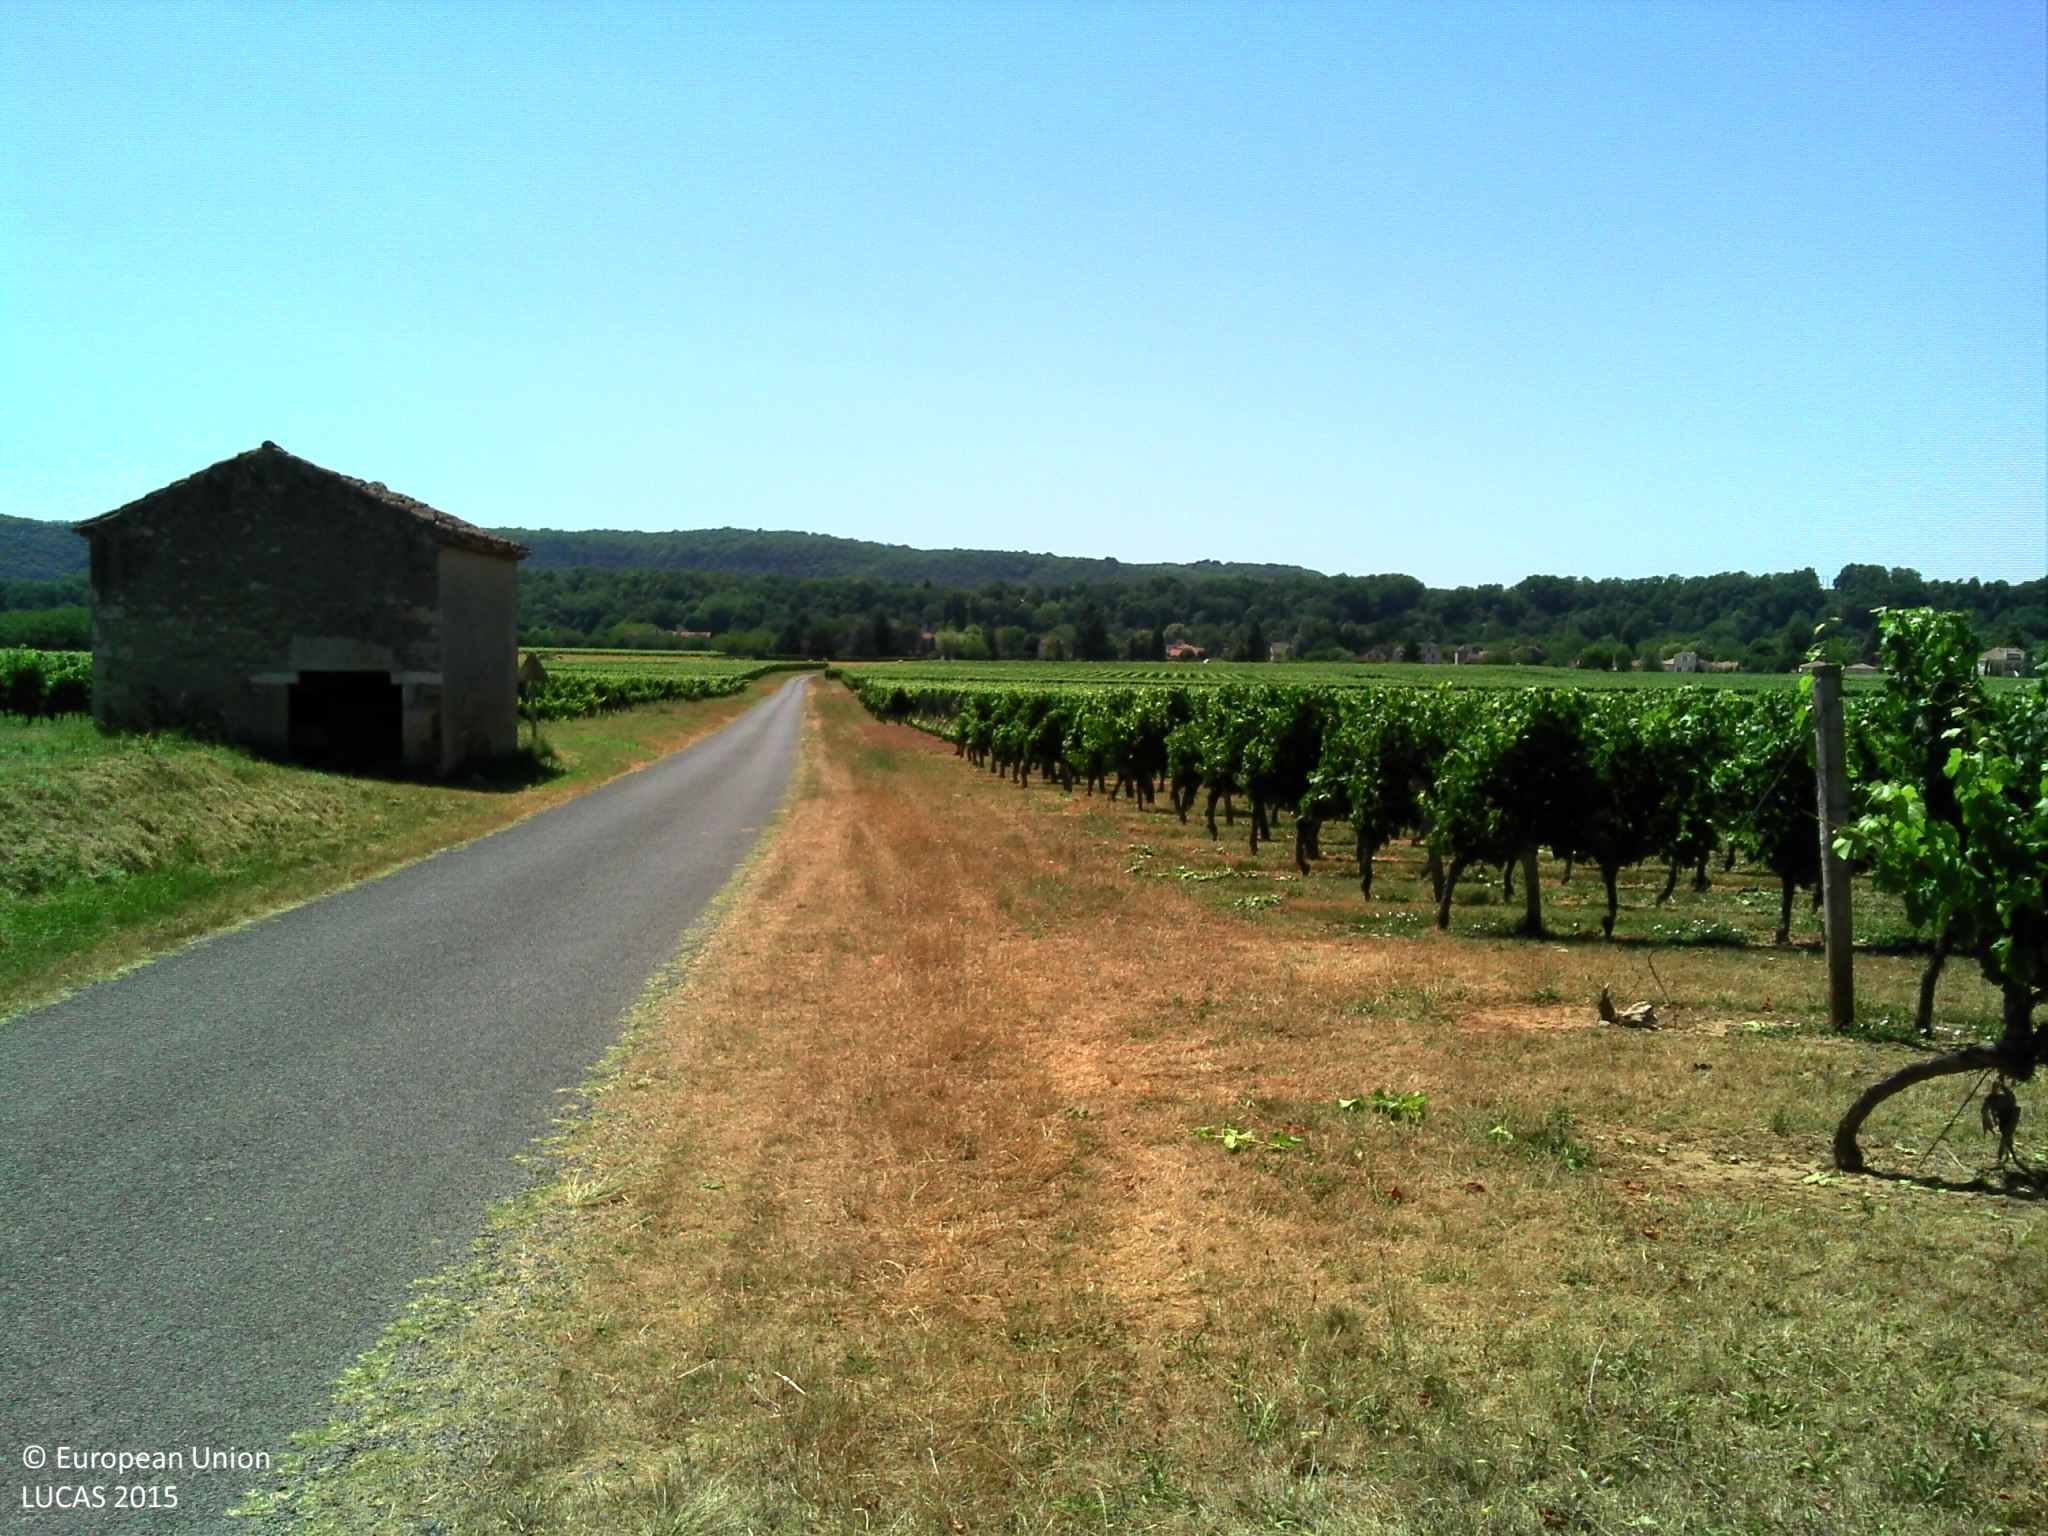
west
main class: Cropland
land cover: Vineyards
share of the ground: > 75 %
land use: Agriculture (excluding fallow land and kitchen gardens)
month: July
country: FR
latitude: 44.4845
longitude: 1.2077
